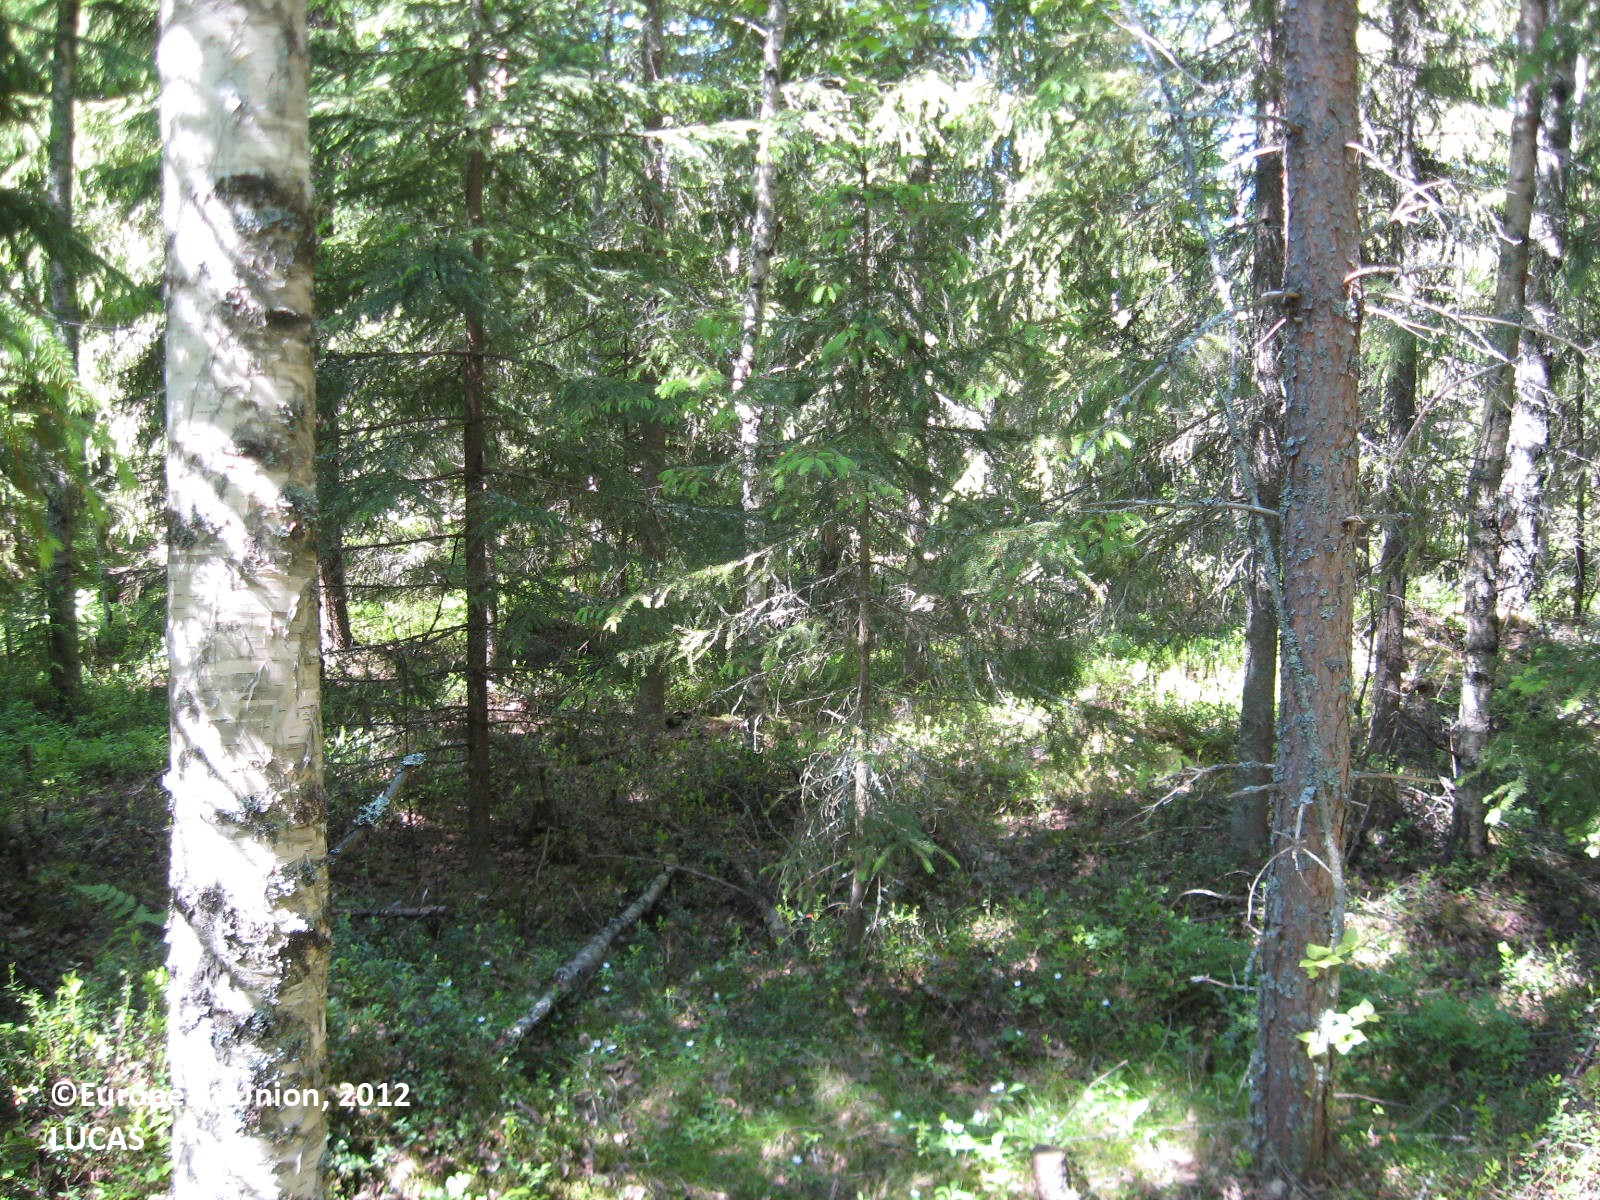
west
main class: Woodland
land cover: Spruce dominated mixed woodland
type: boreal forest
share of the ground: > 75 %
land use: Forestry
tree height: > 5 m
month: June
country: FI
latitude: 62.8049
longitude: 21.3166
